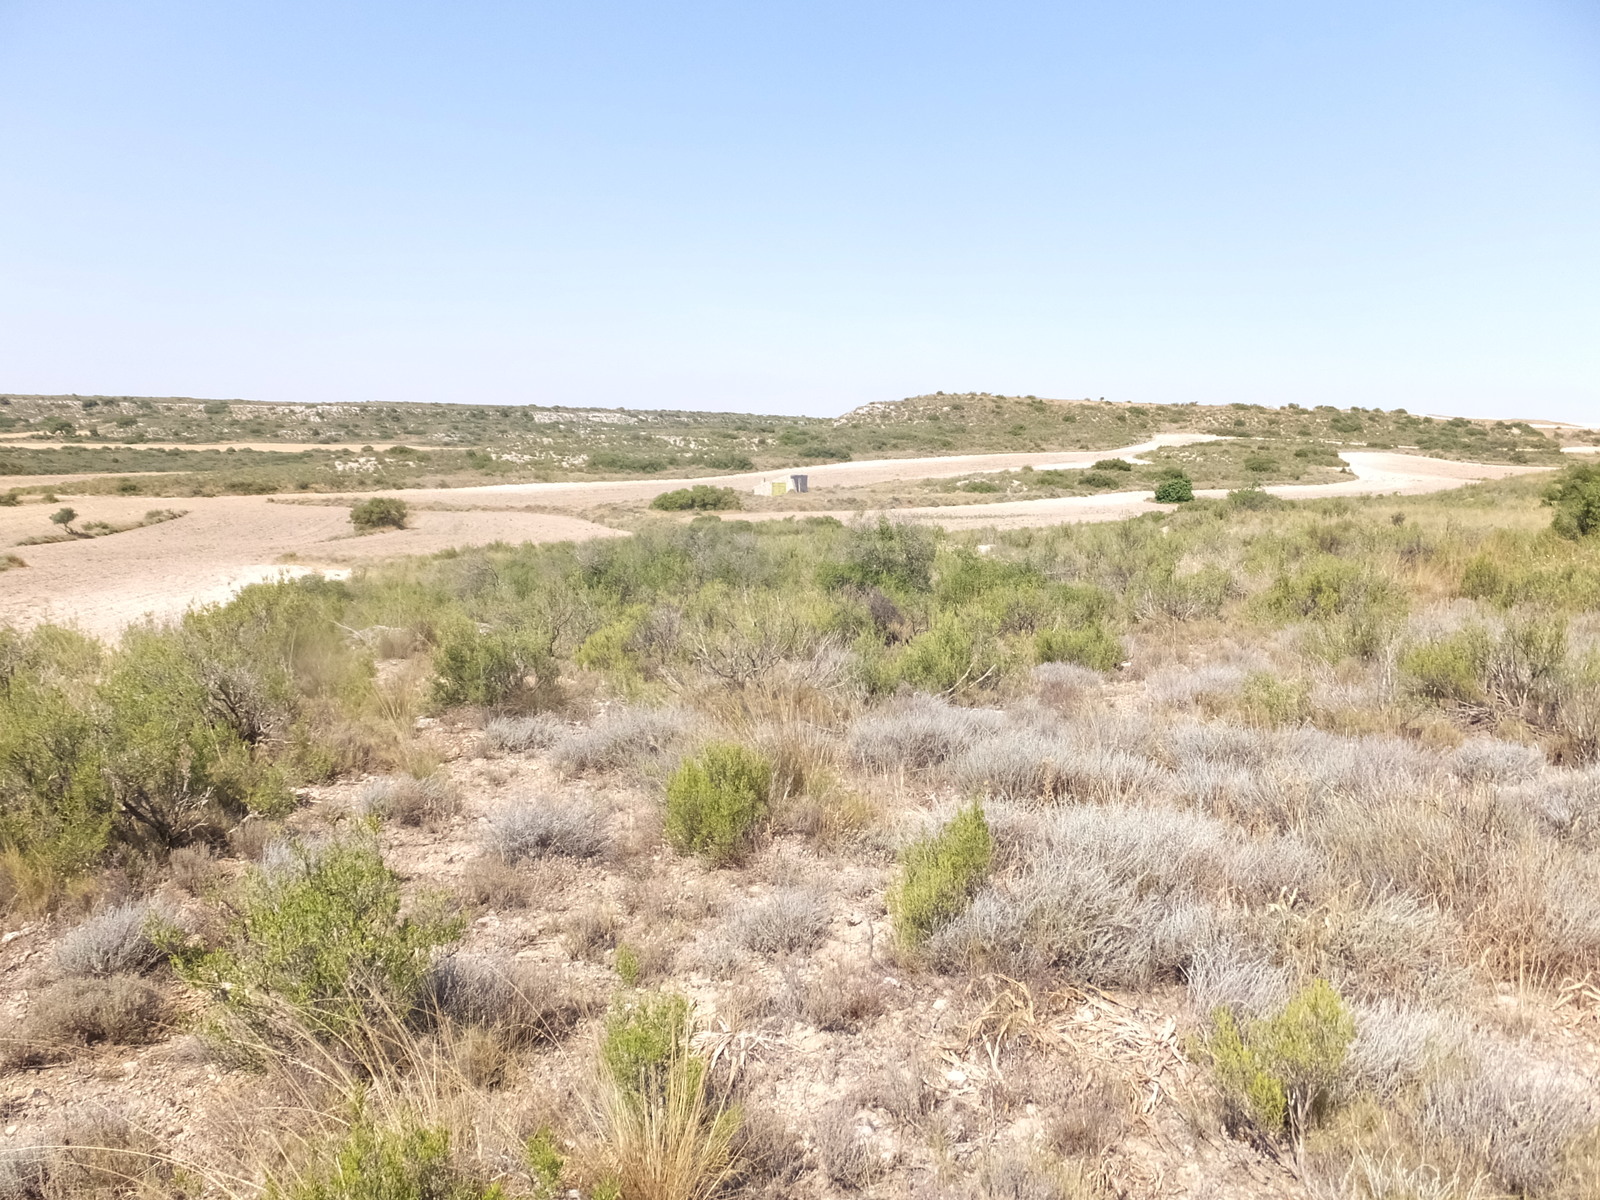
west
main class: Shrubland
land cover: Shrubland with sparse tree cover
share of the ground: > 75 %
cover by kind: shrubs 70 %, herbaceous plants 25 %, coniferous forest trees 5 %
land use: Semi-natural and natural areas not in use
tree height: < 5 m
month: June
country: ES
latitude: 41.3843
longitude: -0.0949
